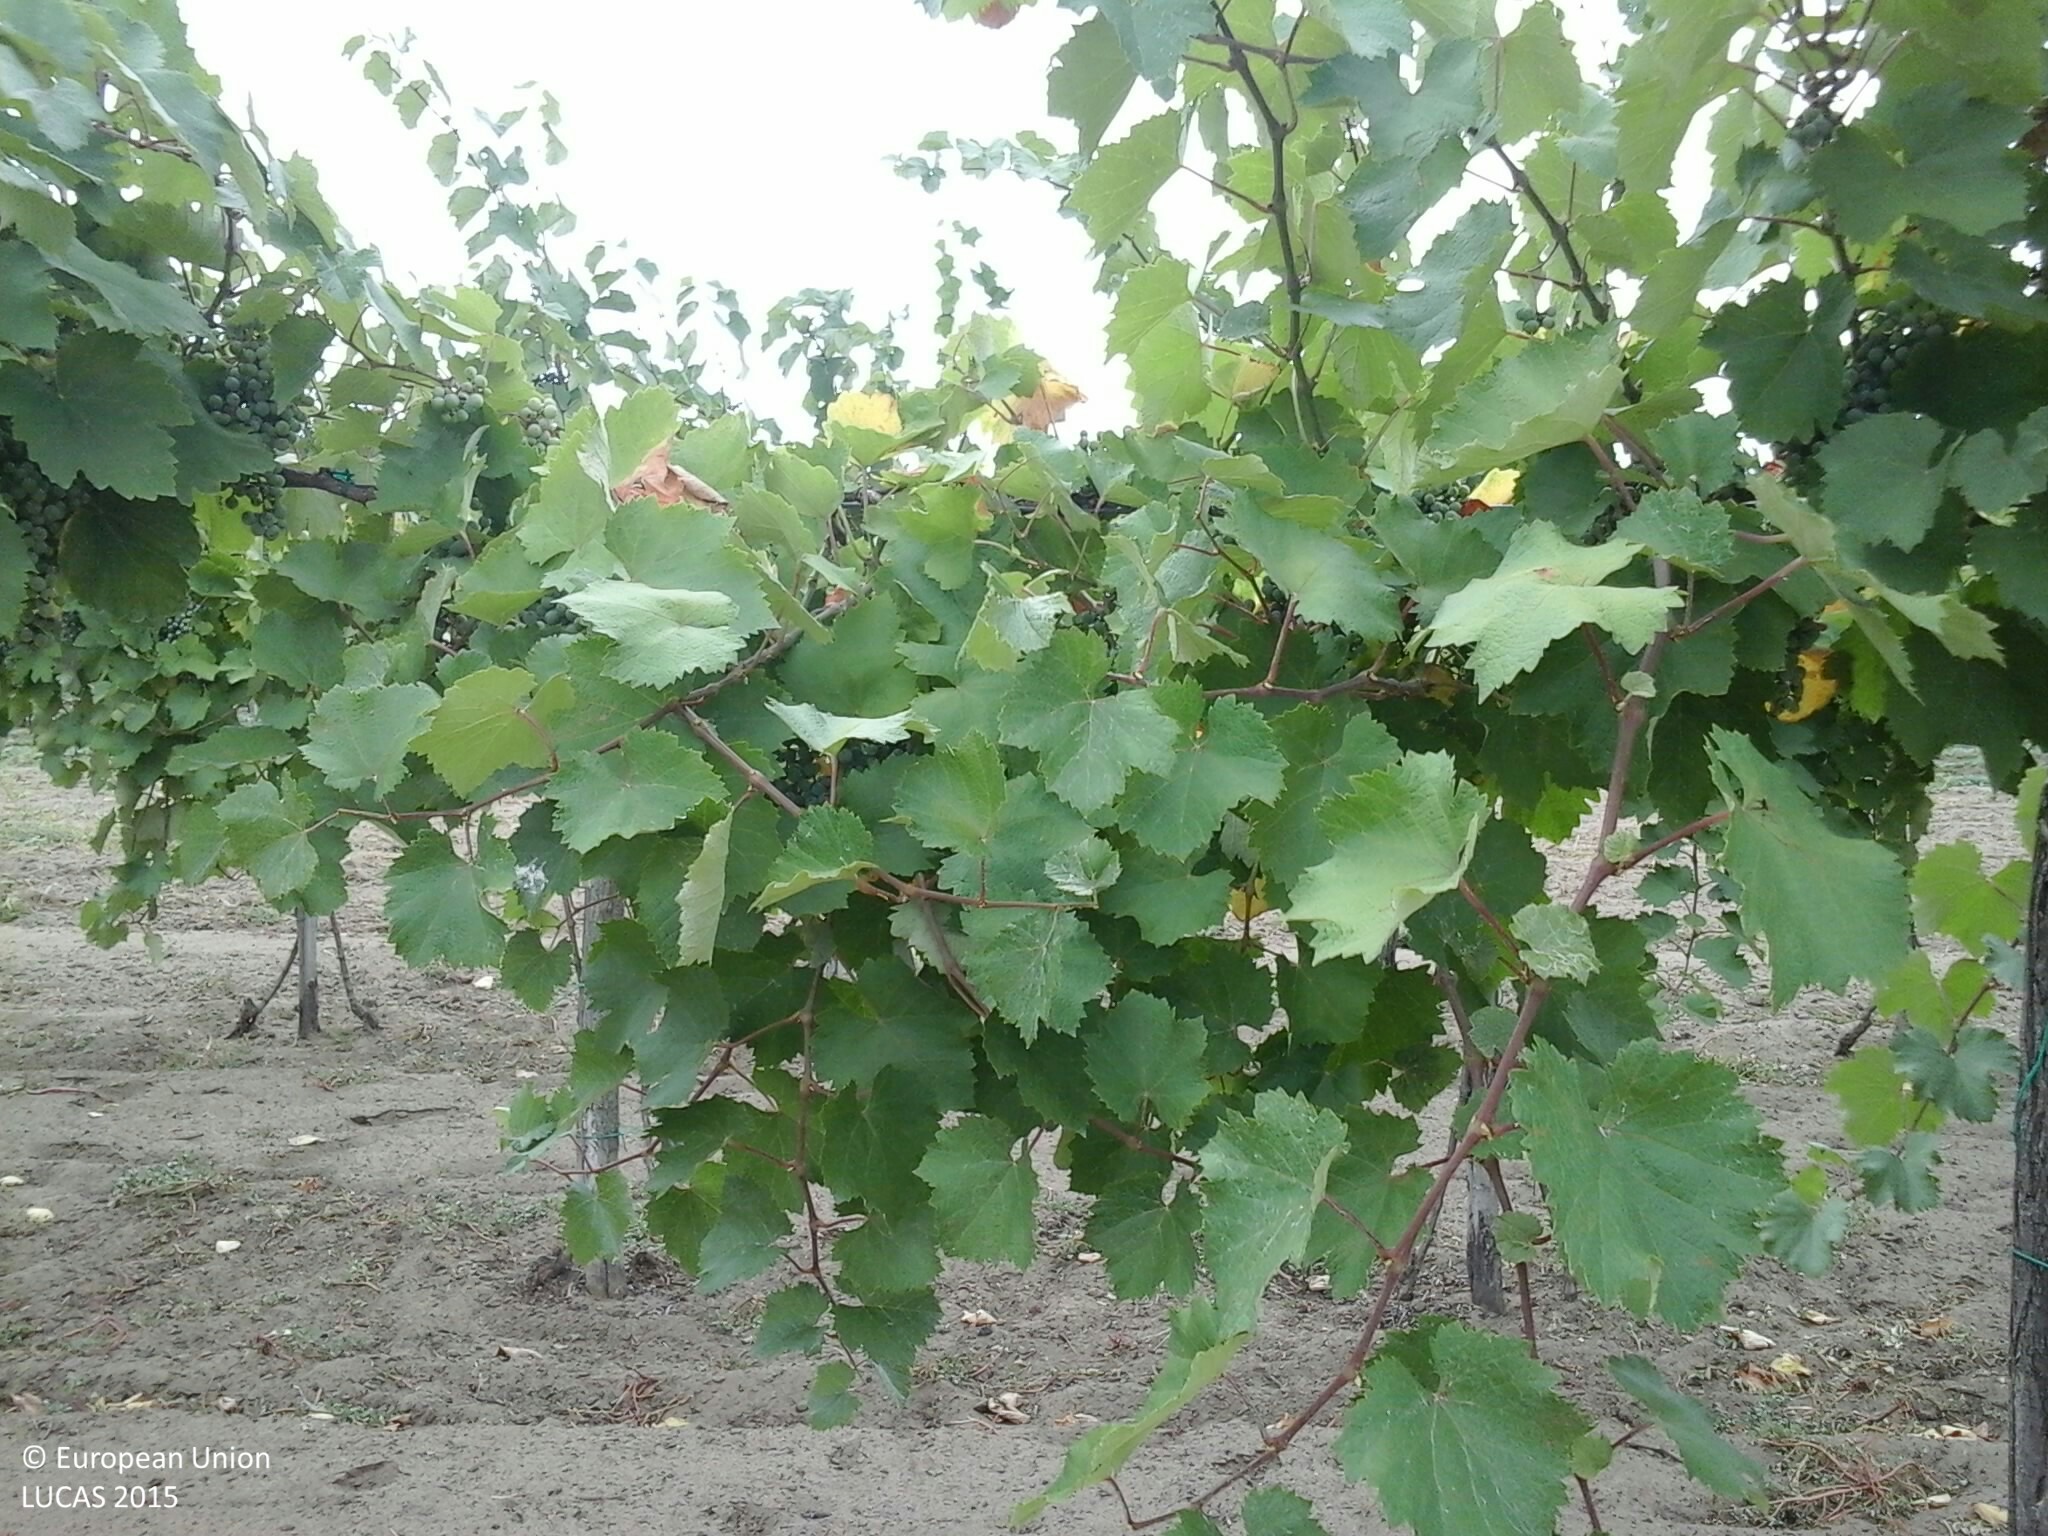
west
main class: Cropland
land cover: Vineyards
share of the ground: 25 - 50 %
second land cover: Other bare soil
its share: > 75 %
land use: Agriculture (excluding fallow land and kitchen gardens)
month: July
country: HU
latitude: 46.8484
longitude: 20.1355
